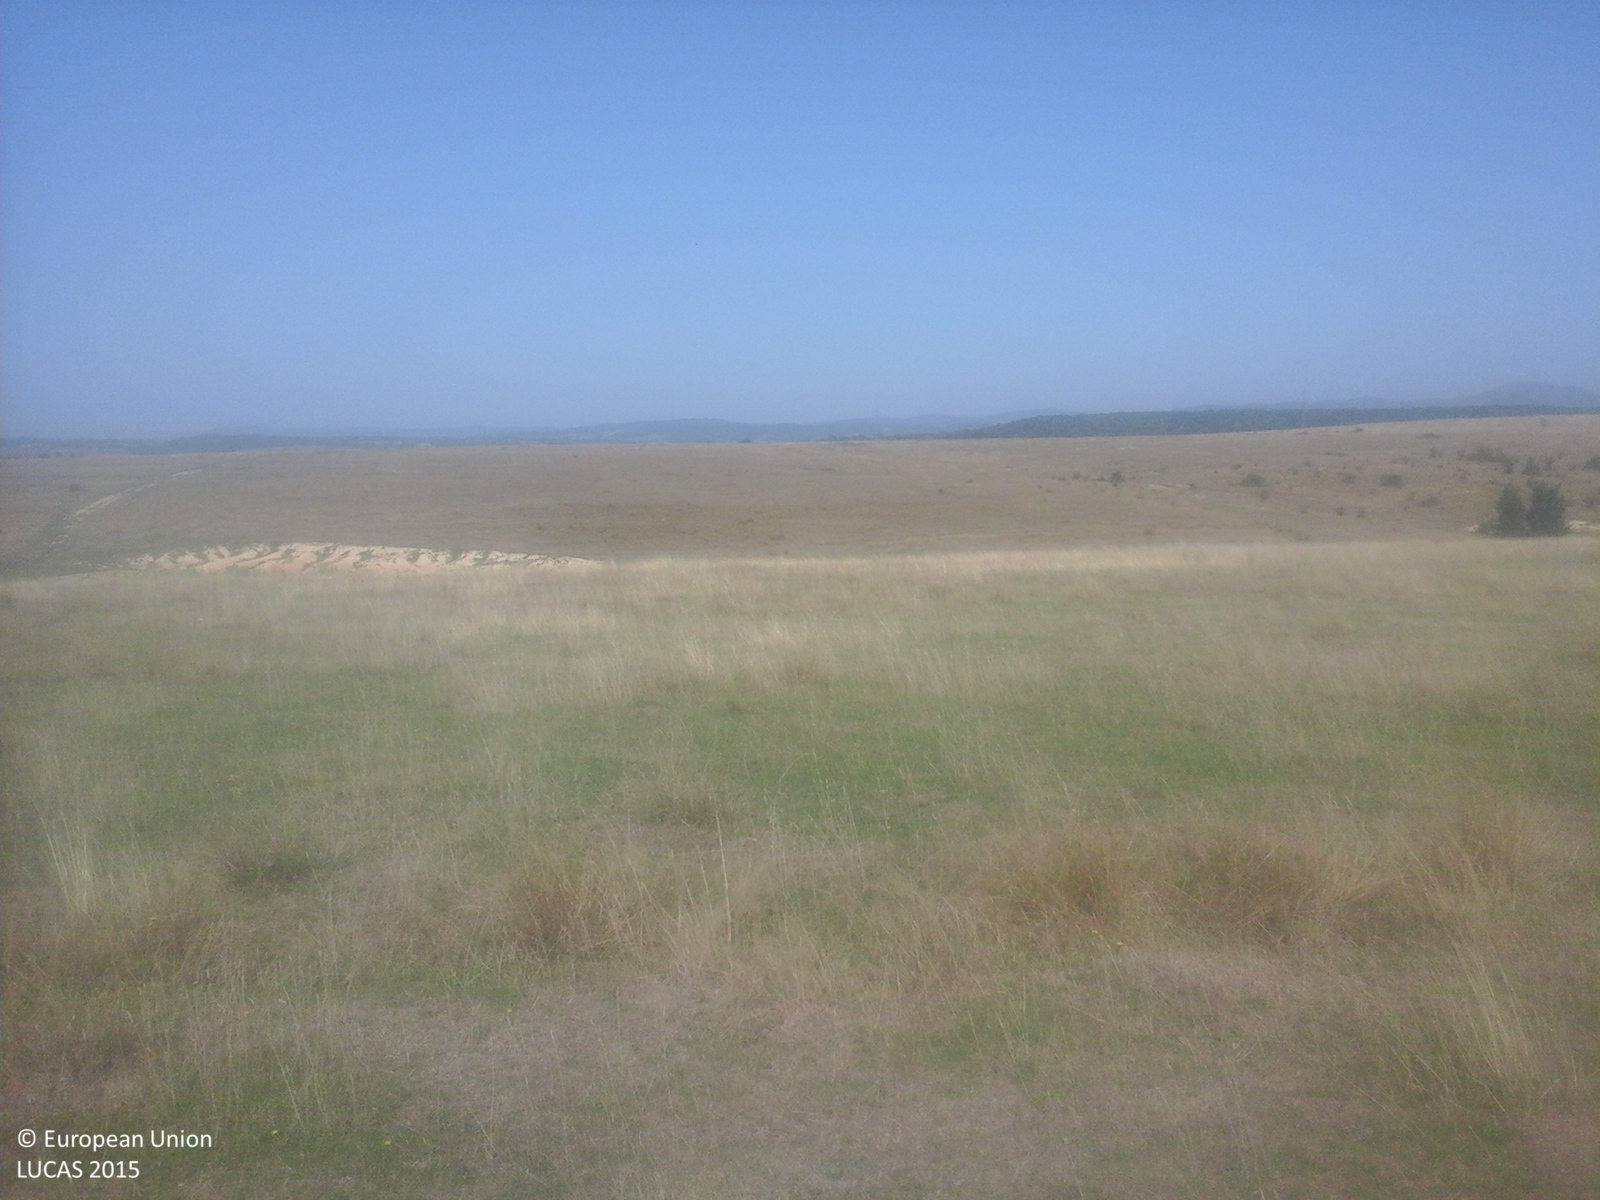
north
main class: Grassland
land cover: Grassland without tree/shrub cover
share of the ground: > 75 %
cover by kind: herbaceous plants 100 %
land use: Agriculture (excluding fallow land and kitchen gardens)
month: September
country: RO
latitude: 46.6881
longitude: 22.3543
